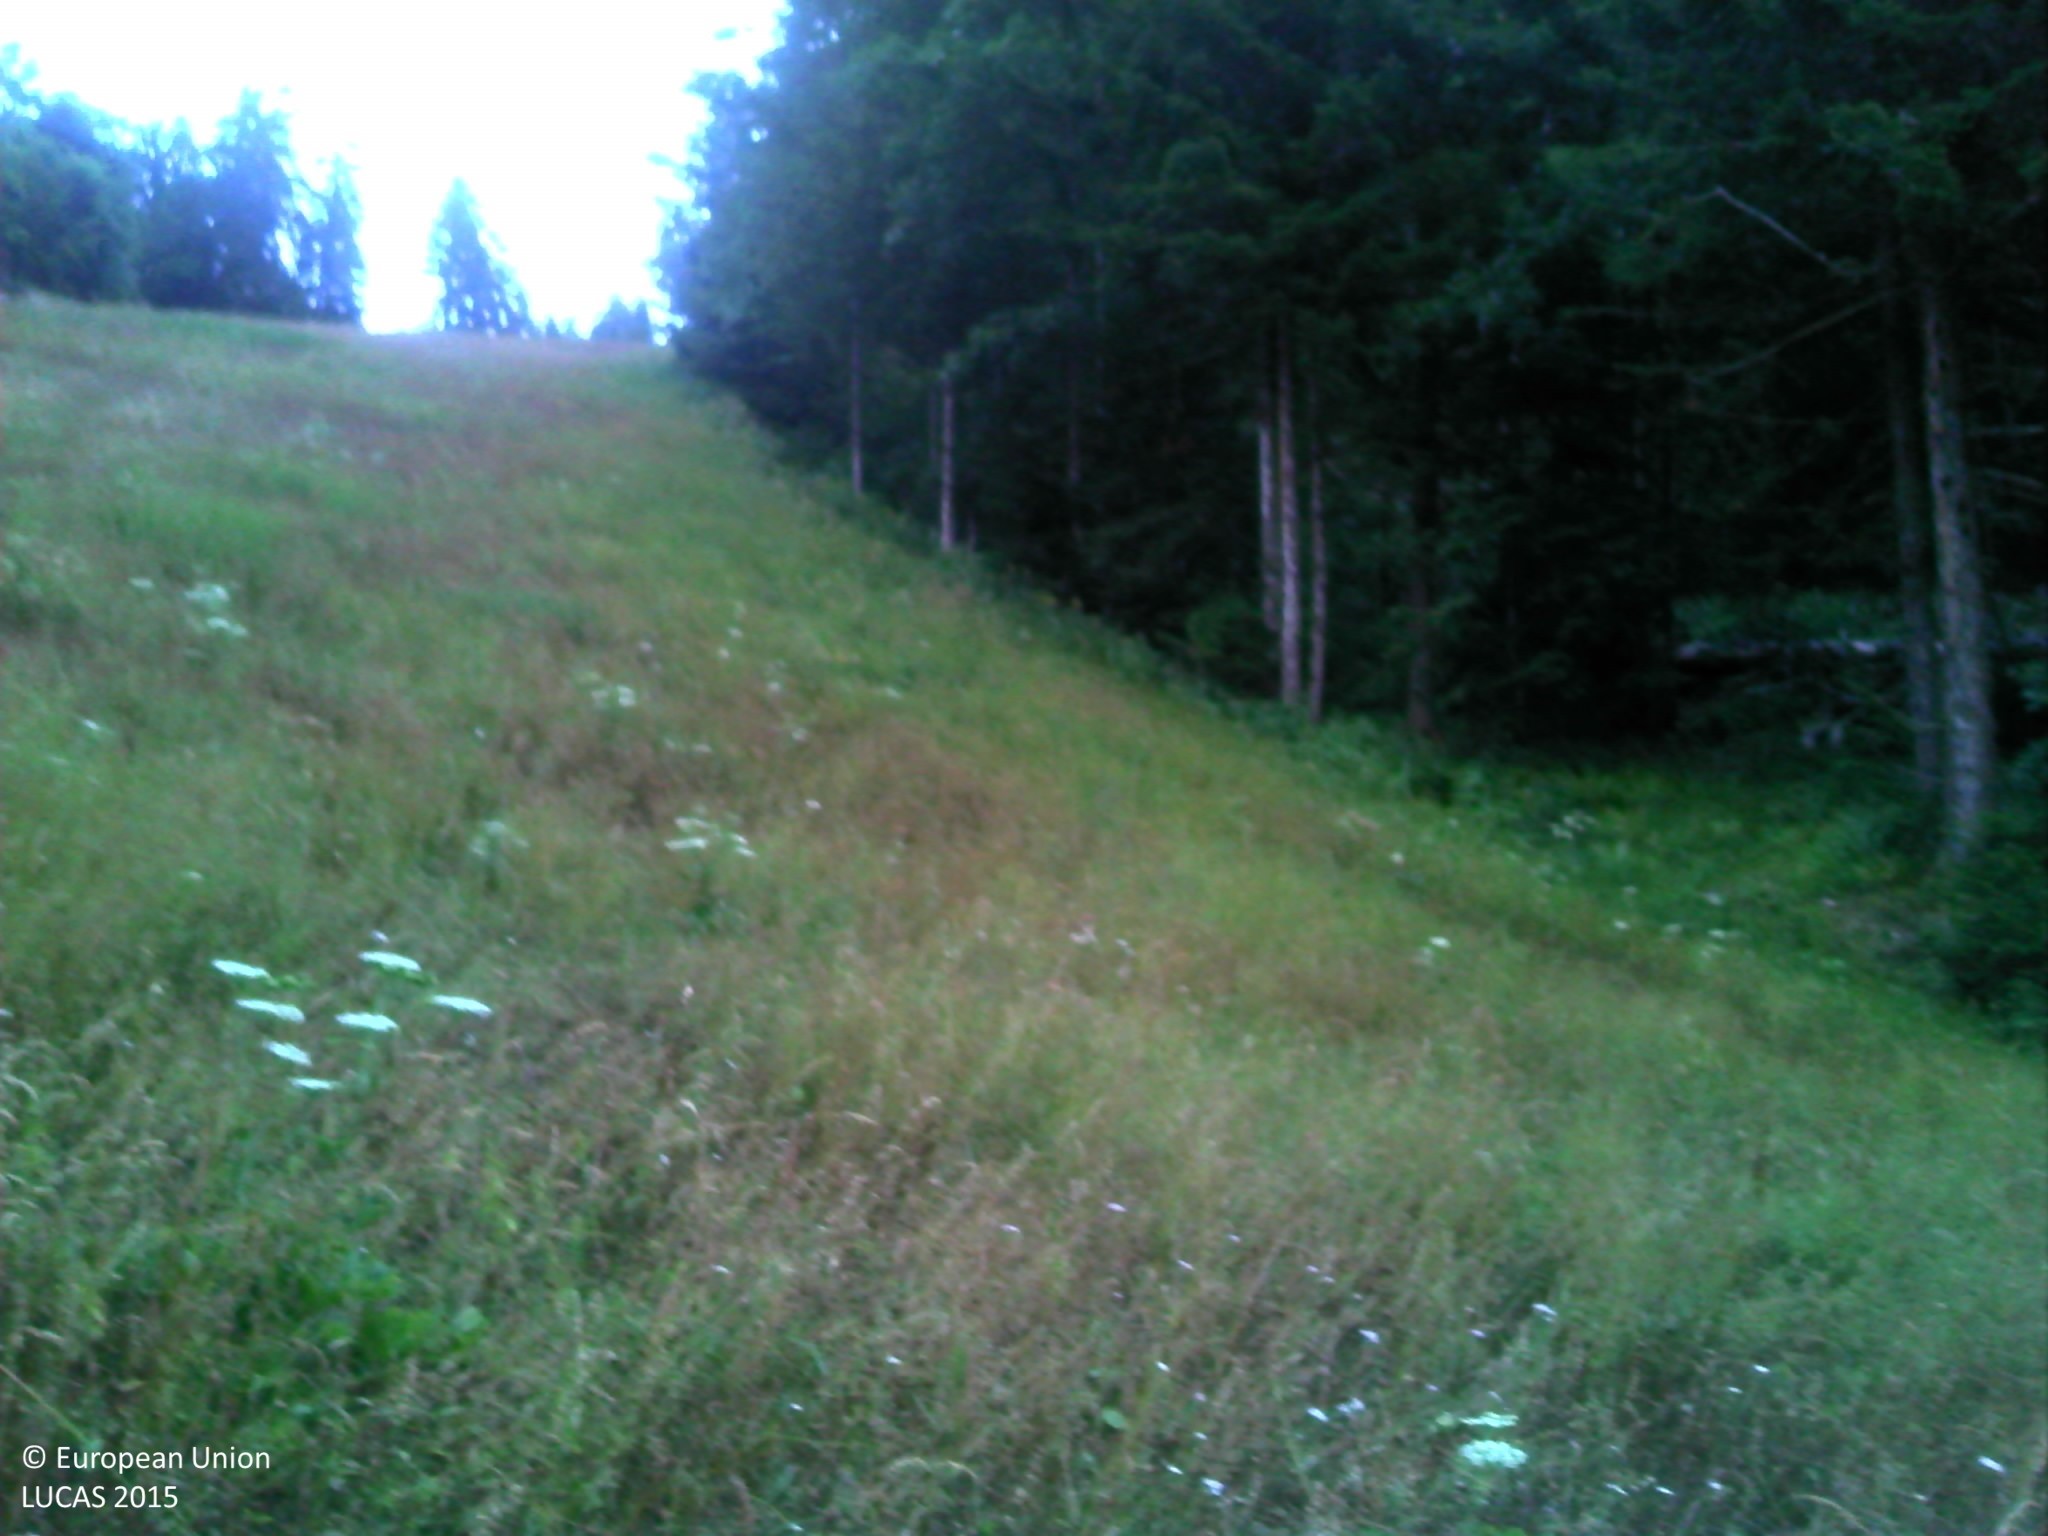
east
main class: Grassland
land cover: Grassland without tree/shrub cover
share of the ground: > 75 %
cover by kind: herbaceous plants 100 %
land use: Agriculture (excluding fallow land and kitchen gardens)
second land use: Sport
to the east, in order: Grassland without tree/shrub cover; Tracks; Other mixed woodland; Grass margins; Paved roads, cycling and walking lanes; Other mixed woodland; Spontaneously vegetated surfaces; Other mixed woodland
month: July
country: FR
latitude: 45.2316
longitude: 5.5854
